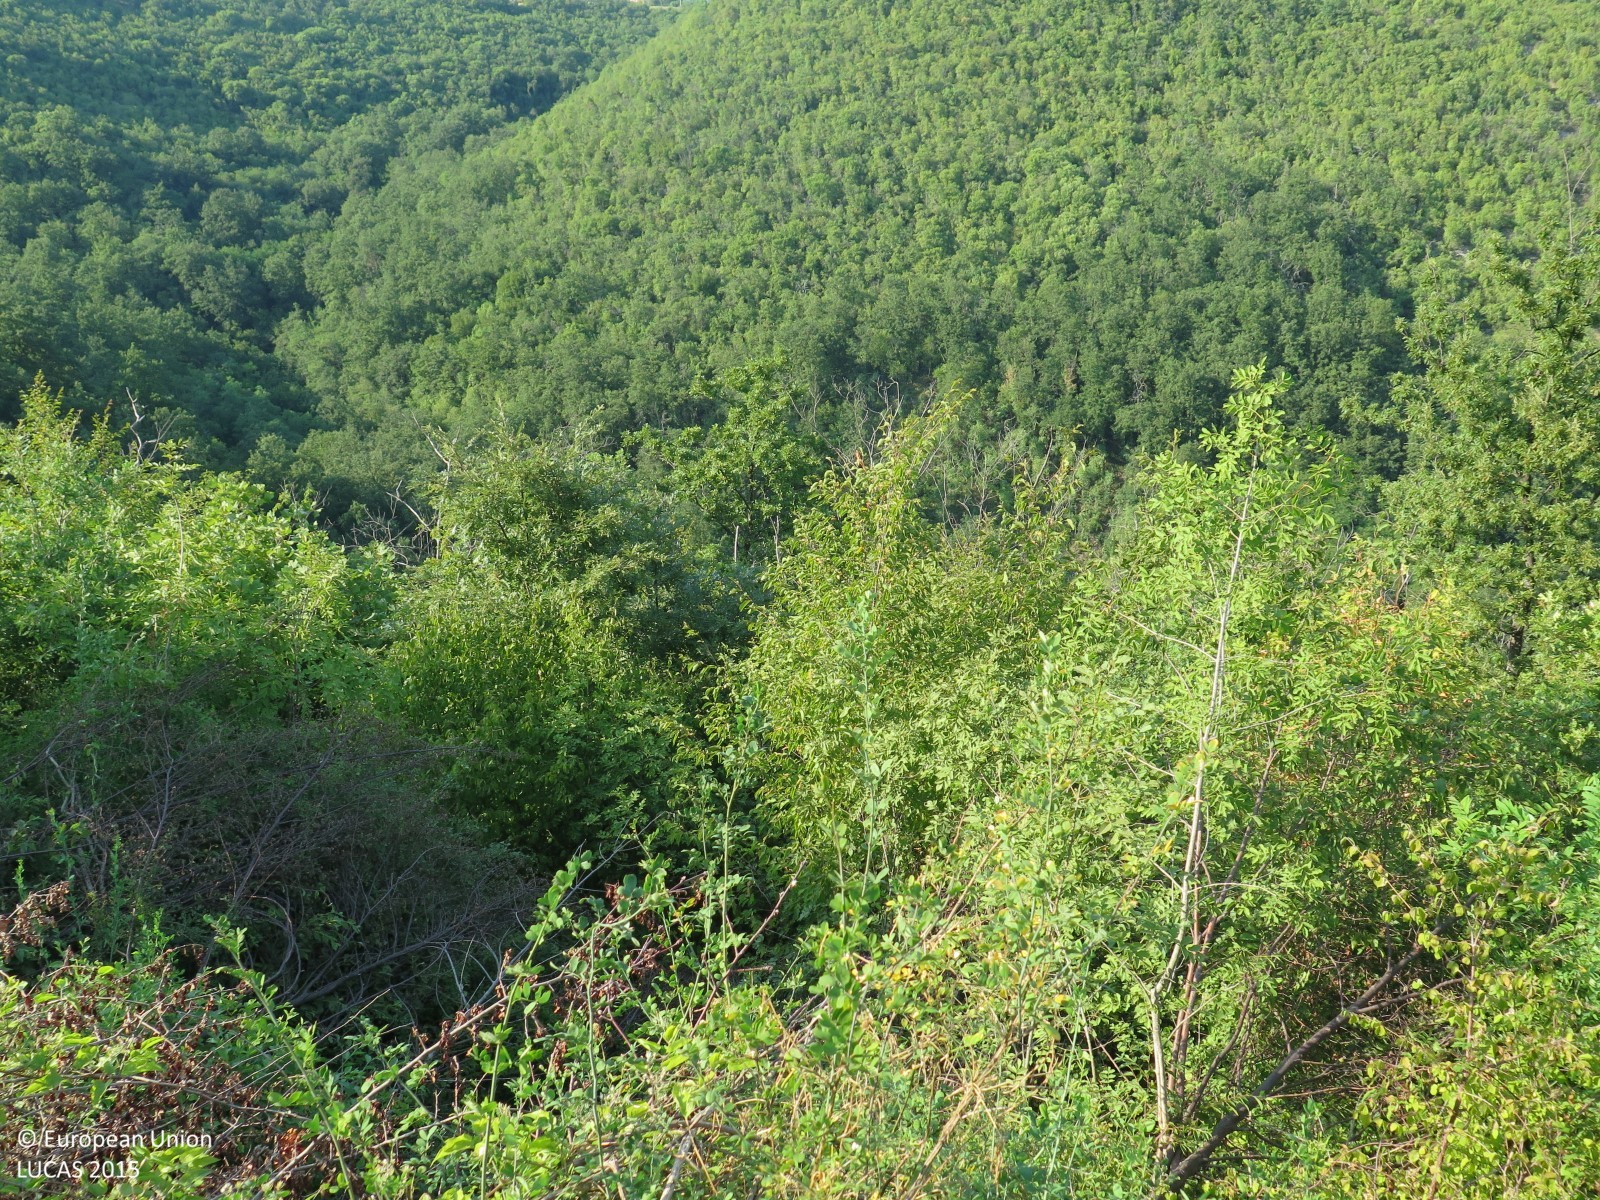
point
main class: Woodland
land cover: Broadleaved woodland
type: acidophilous oak and oak-birch forest
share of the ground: > 75 %
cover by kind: broadleaved forest trees 90 %, shrubs 5 %, herbaceous plants 5 %
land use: Semi-natural and natural areas not in use
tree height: > 5 m
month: July
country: HR
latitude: 45.1920
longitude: 14.0550
